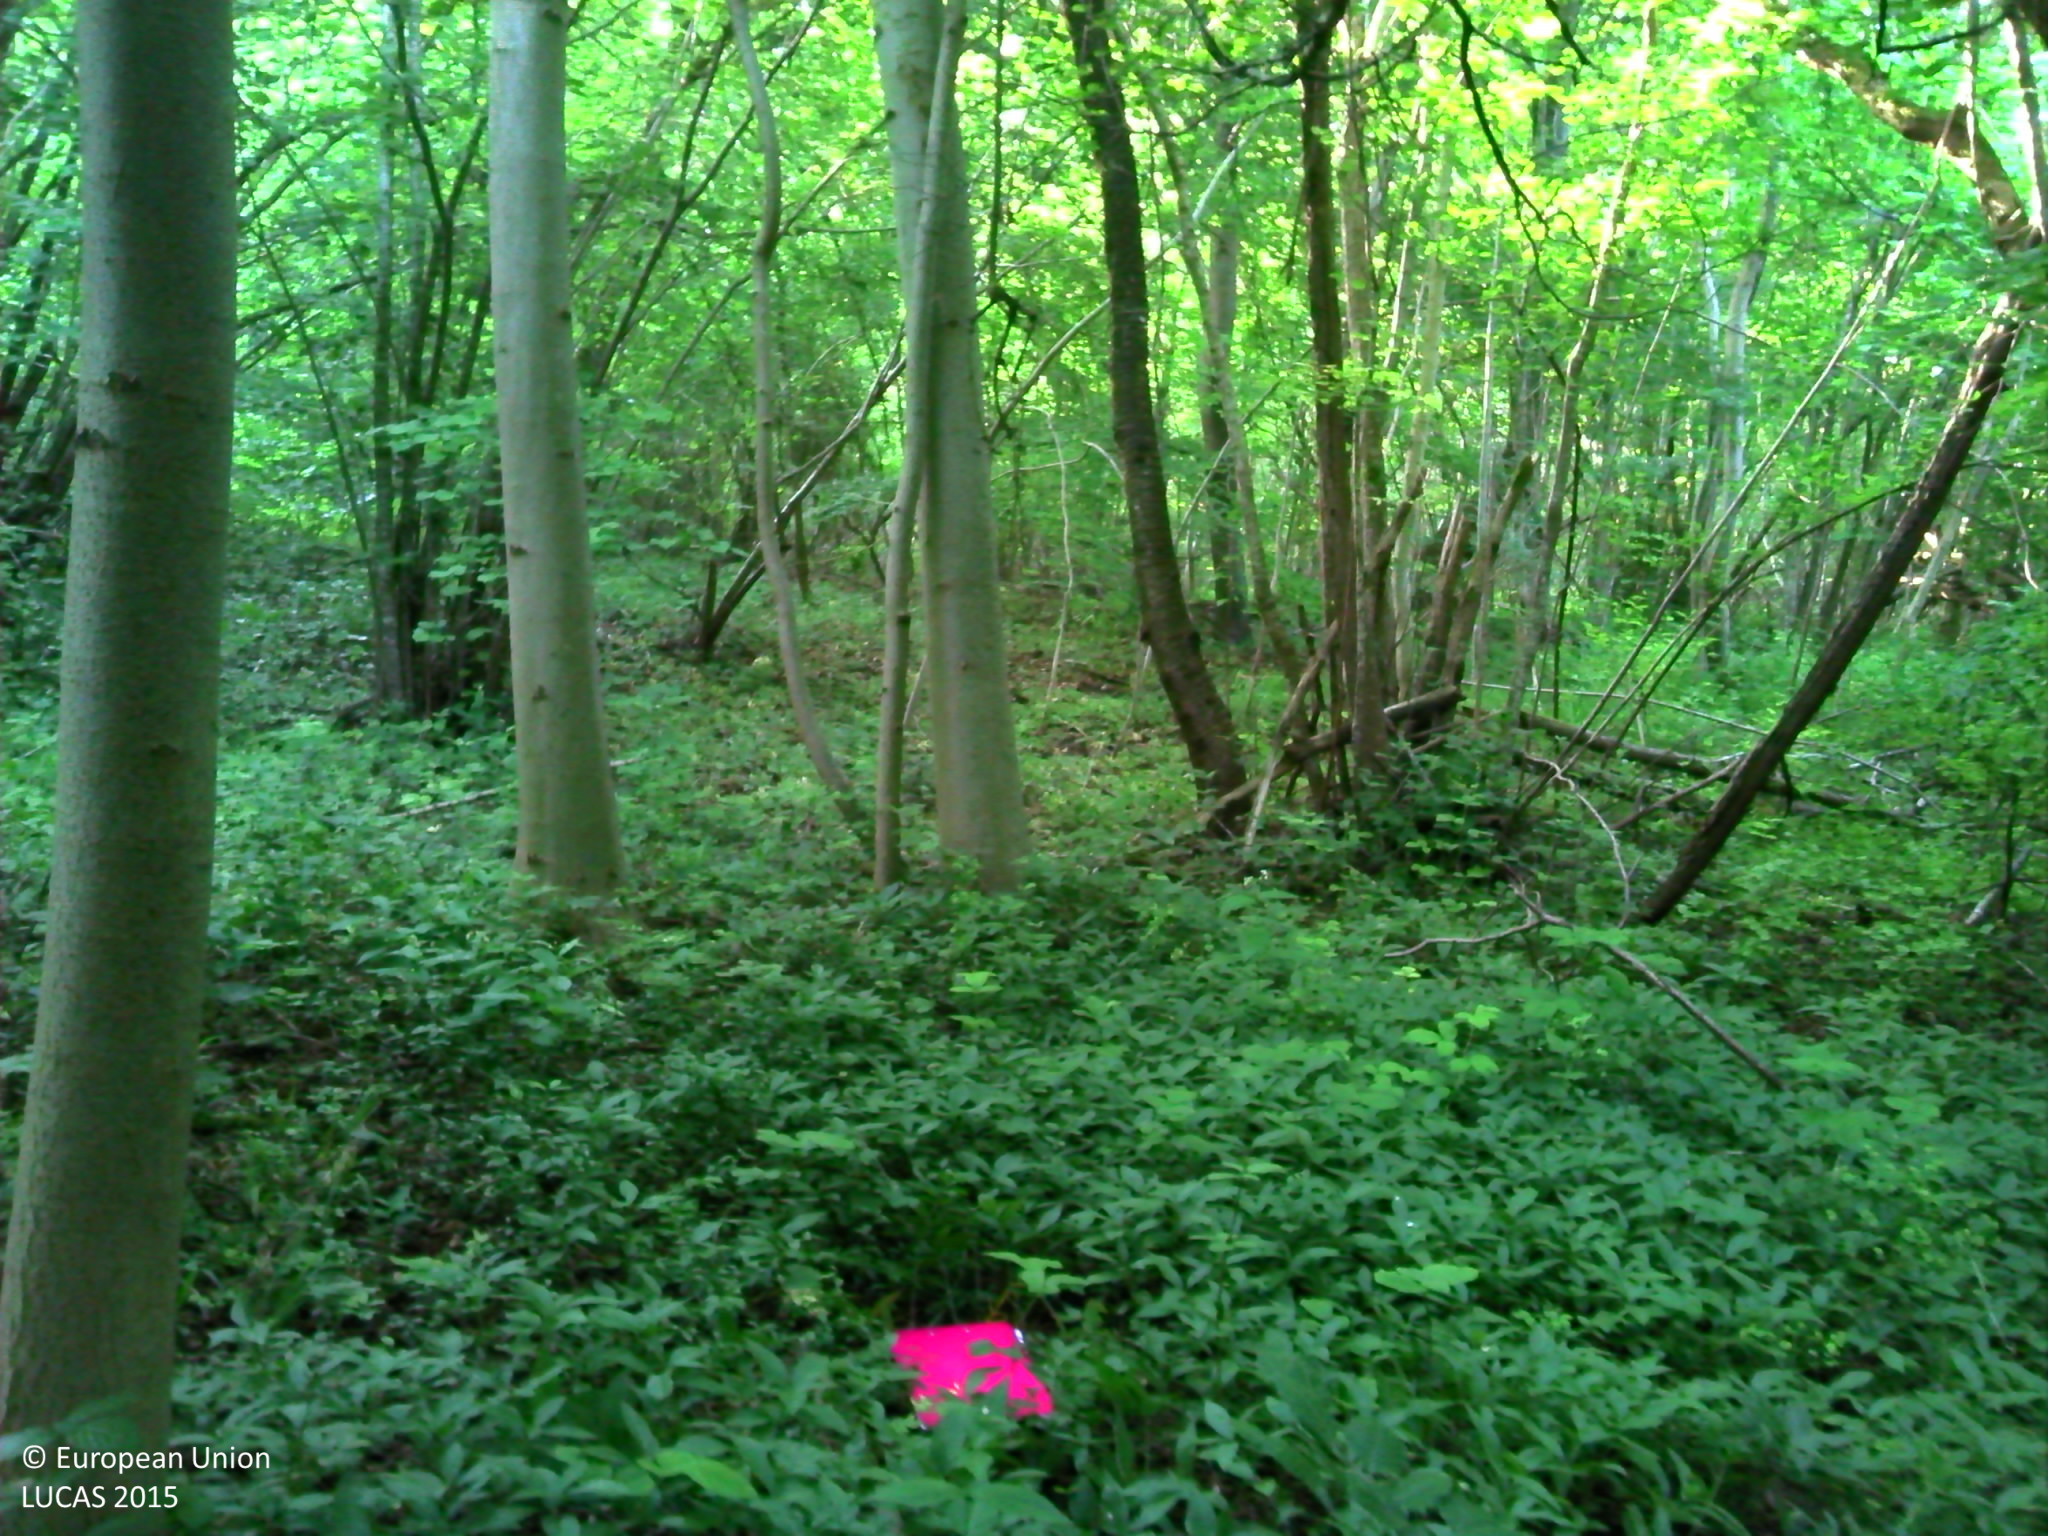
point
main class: Woodland
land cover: Broadleaved woodland
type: mesophytic deciduous forest
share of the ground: > 75 %
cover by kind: broadleaved forest trees 85 %, shrubs 10 %, herbaceous plants 5 %
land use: Forestry
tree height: > 5 m
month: June
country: FR
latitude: 49.5423
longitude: 2.8171
